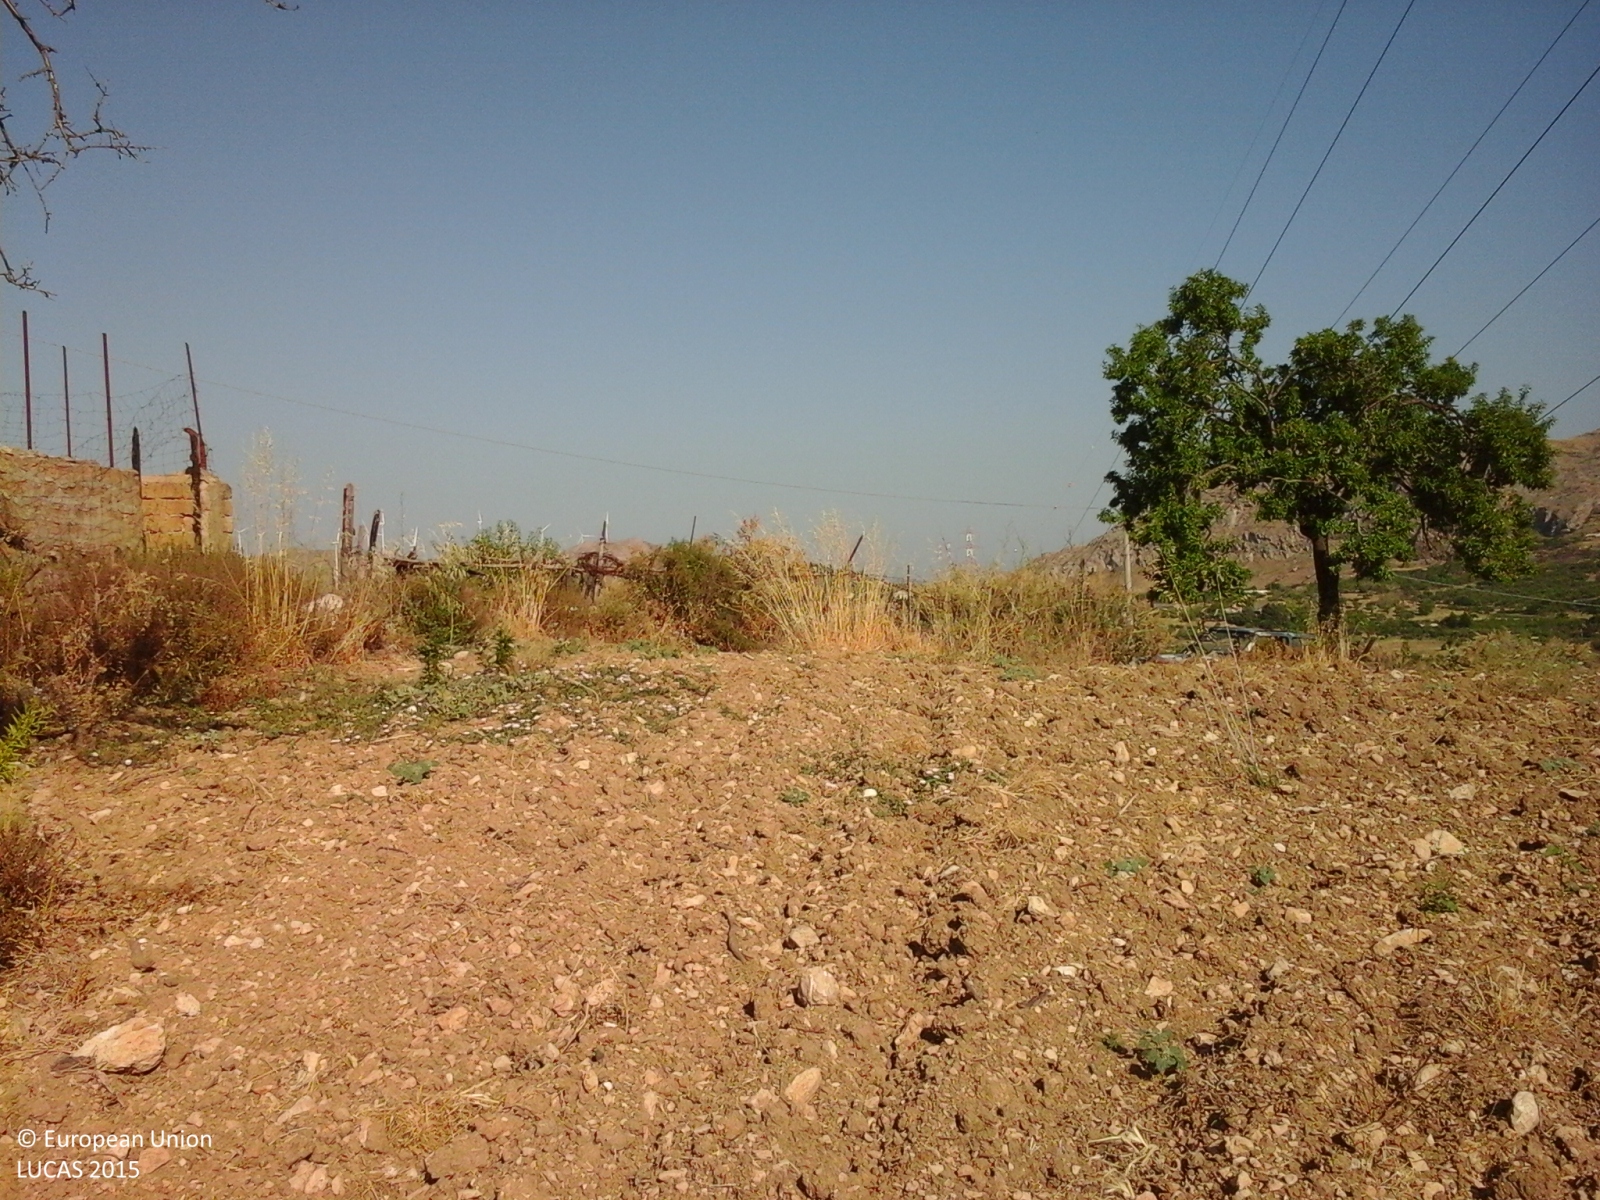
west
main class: Cropland
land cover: Nuts trees
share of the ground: 25 - 50 %
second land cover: Other bare soil
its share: > 75 %
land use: Agriculture (excluding fallow land and kitchen gardens)
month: July
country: IT
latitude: 37.4284
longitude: 13.5101
